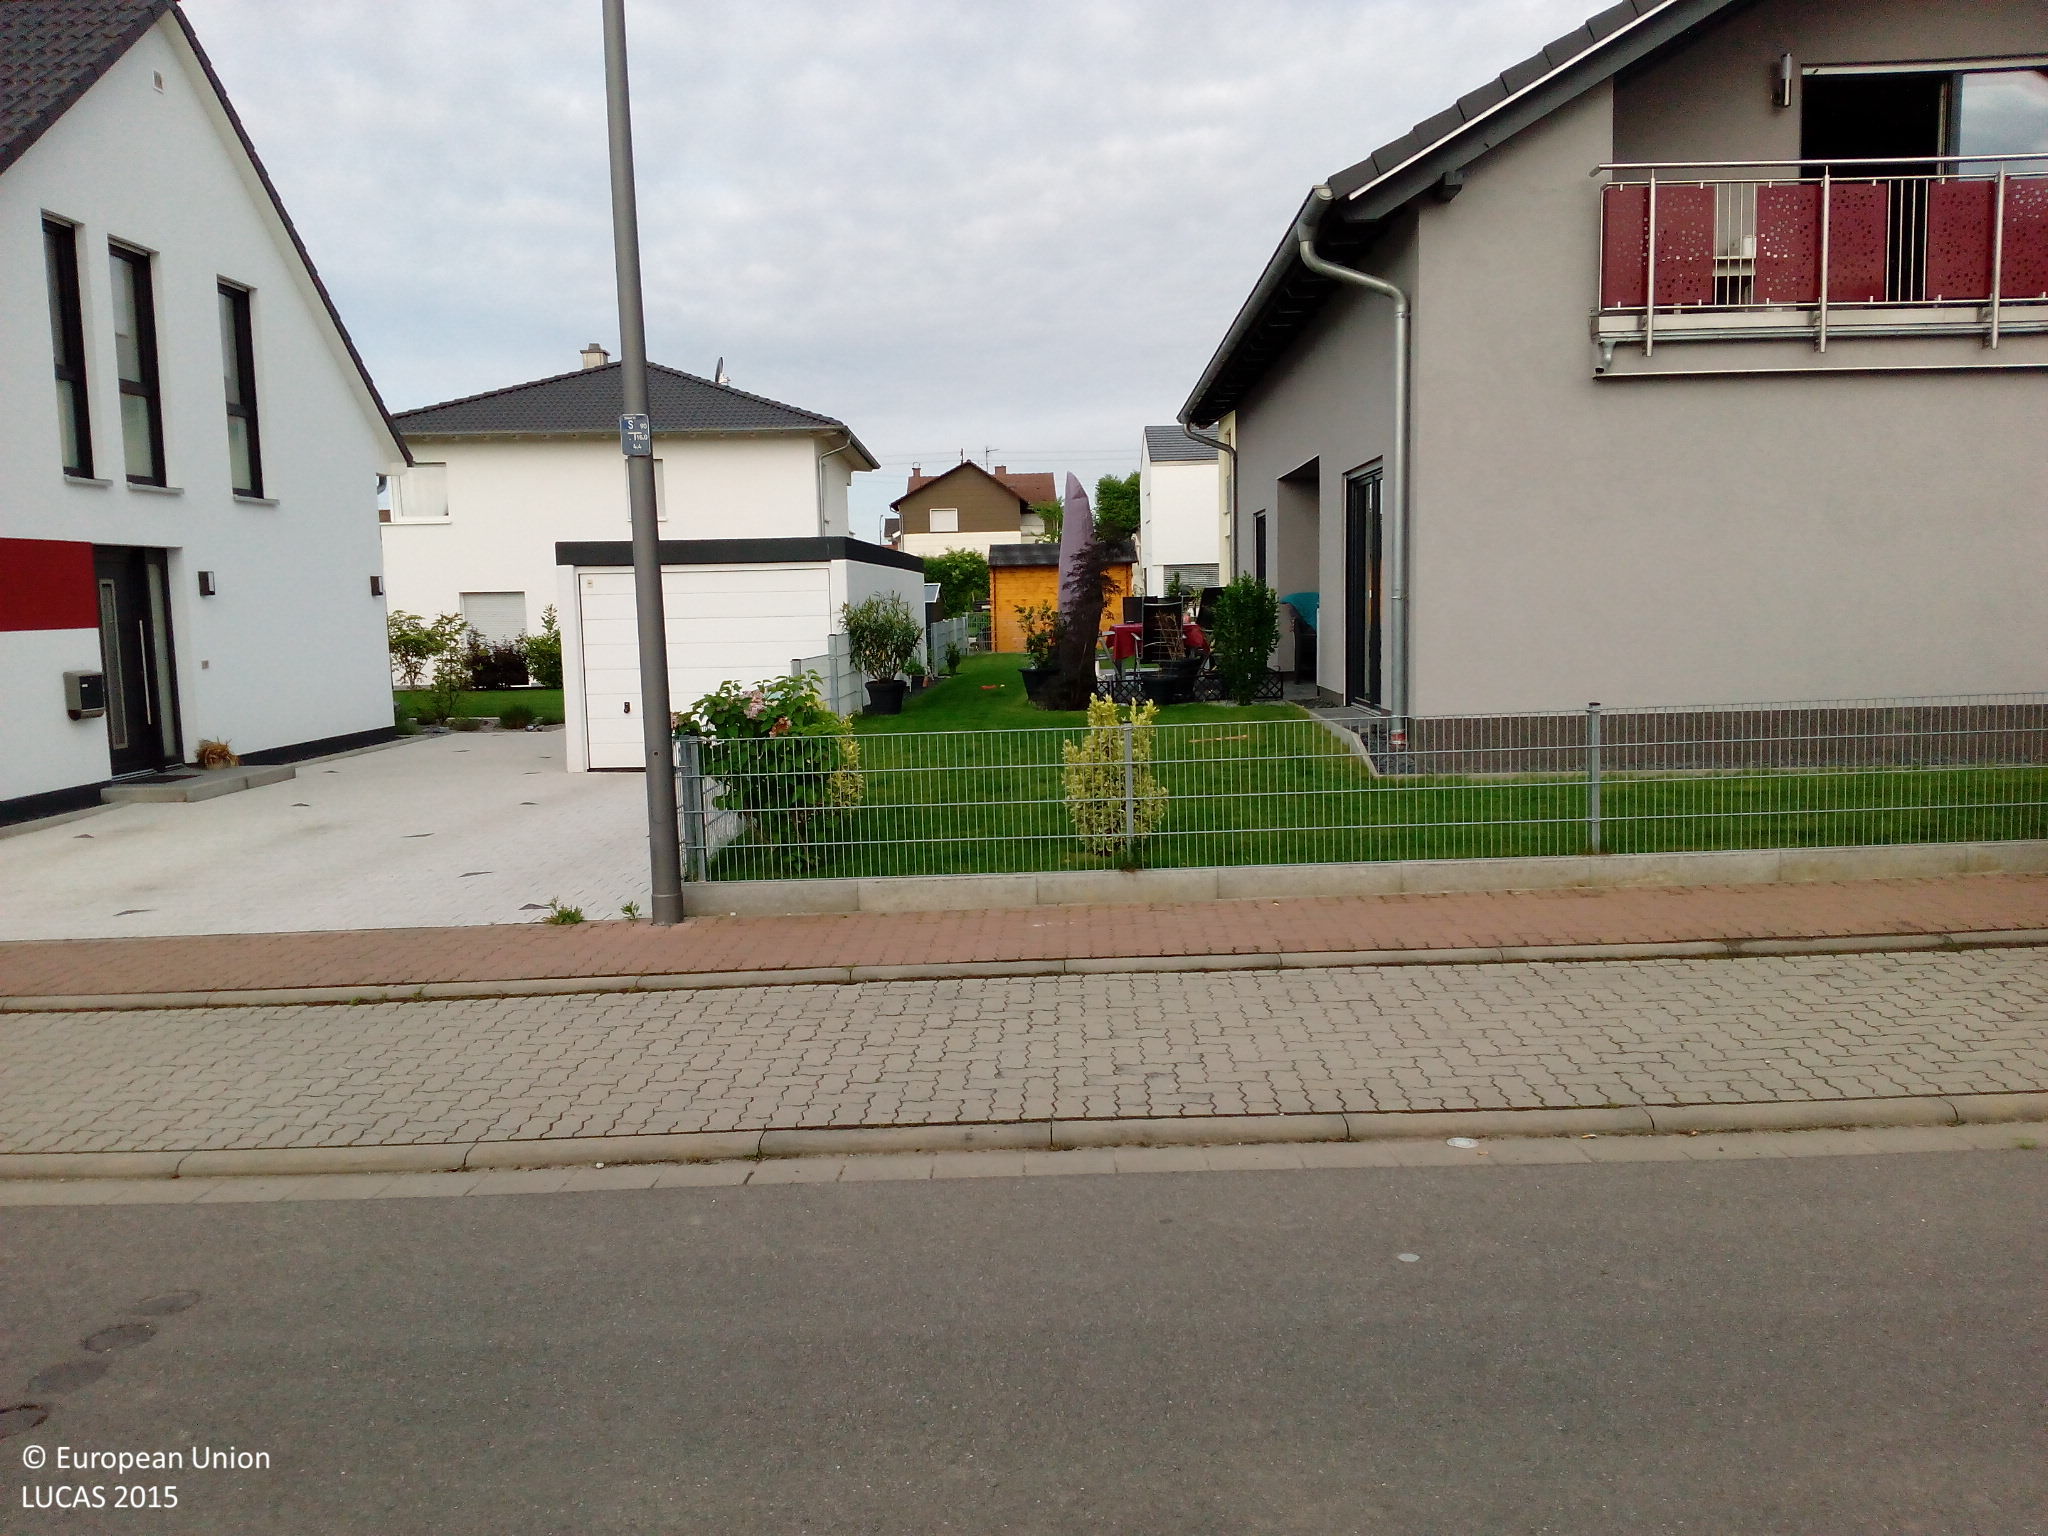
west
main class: Grassland
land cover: Grassland without tree/shrub cover
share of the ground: > 75 %
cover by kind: herbaceous plants 95 %, unconsolidated bare surface 5 %
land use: Residential
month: May
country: DE
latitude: 49.0719
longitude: 8.1526
